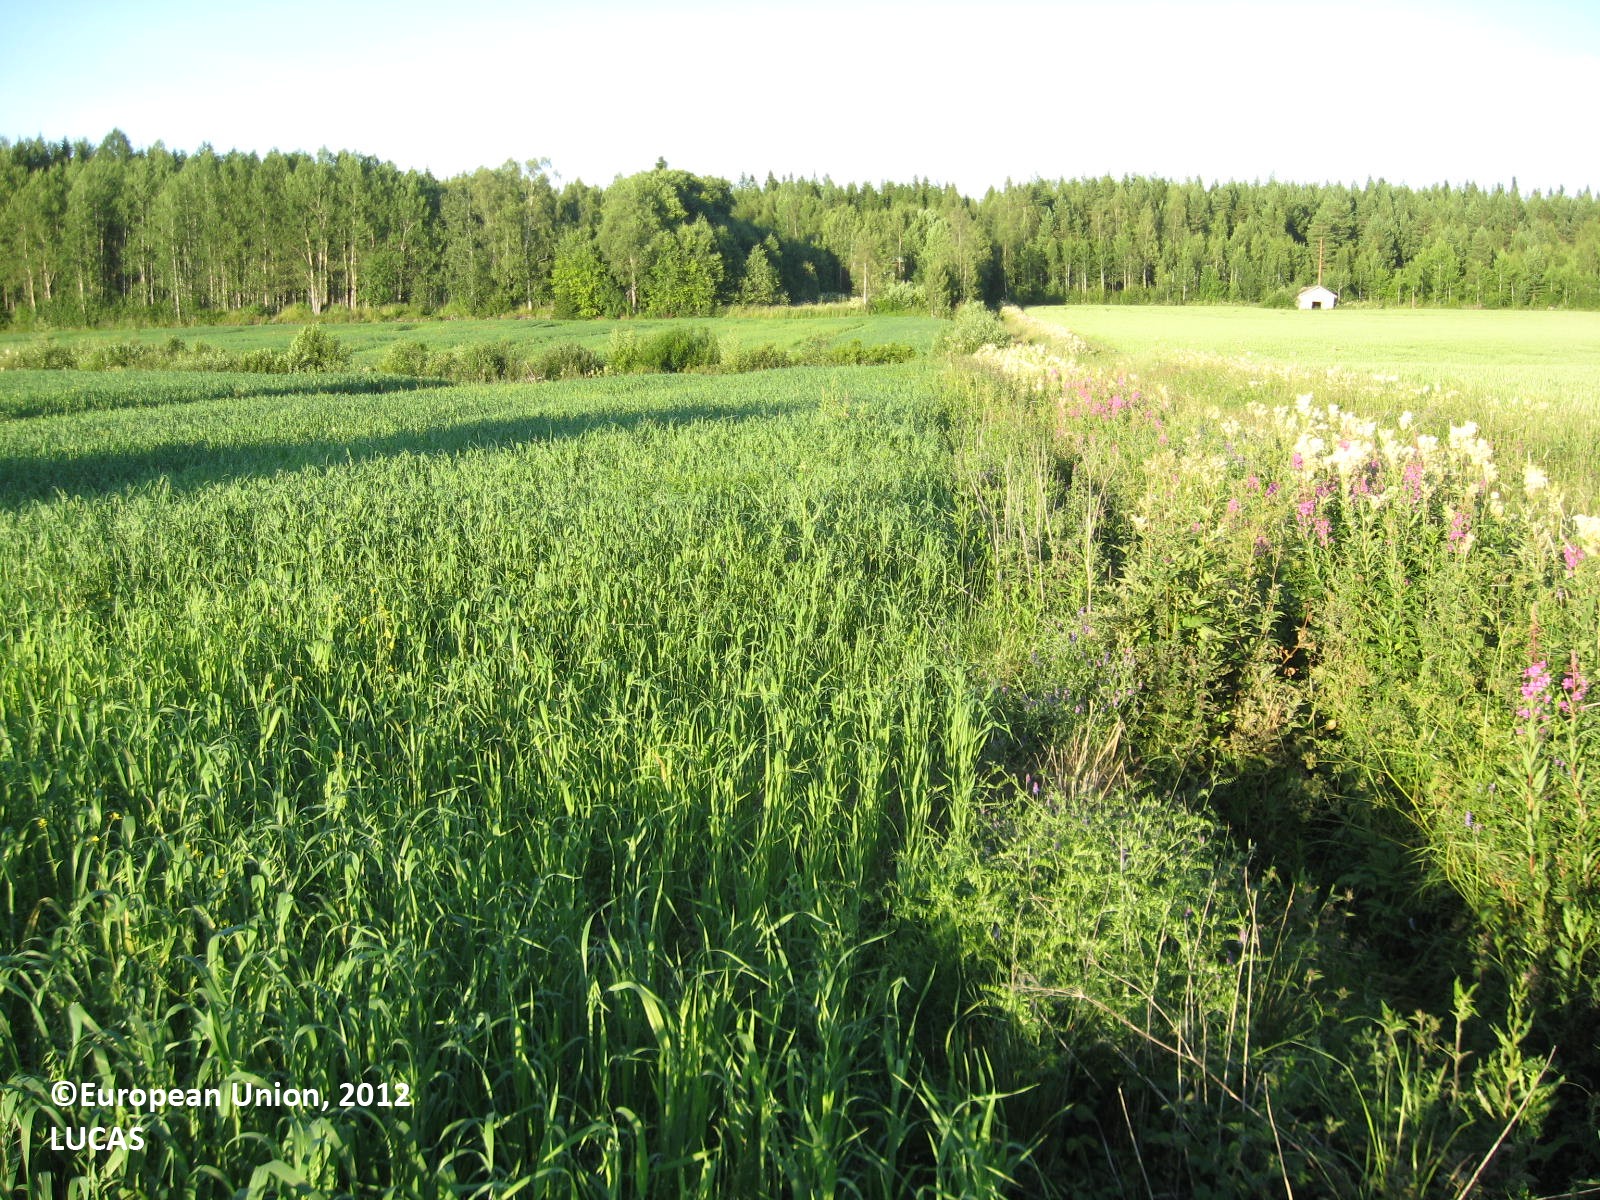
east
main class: Cropland
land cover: Oats
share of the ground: > 75 %
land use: Agriculture (excluding fallow land and kitchen gardens)
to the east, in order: Oats; Shruby margins; Broadleaved woodland; Rivers and streams; Shruby margins; Oats; Ditches and canals; Broadleaved woodland; Shrubland without tree cover
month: July
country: FI
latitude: 62.1460
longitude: 21.5774
